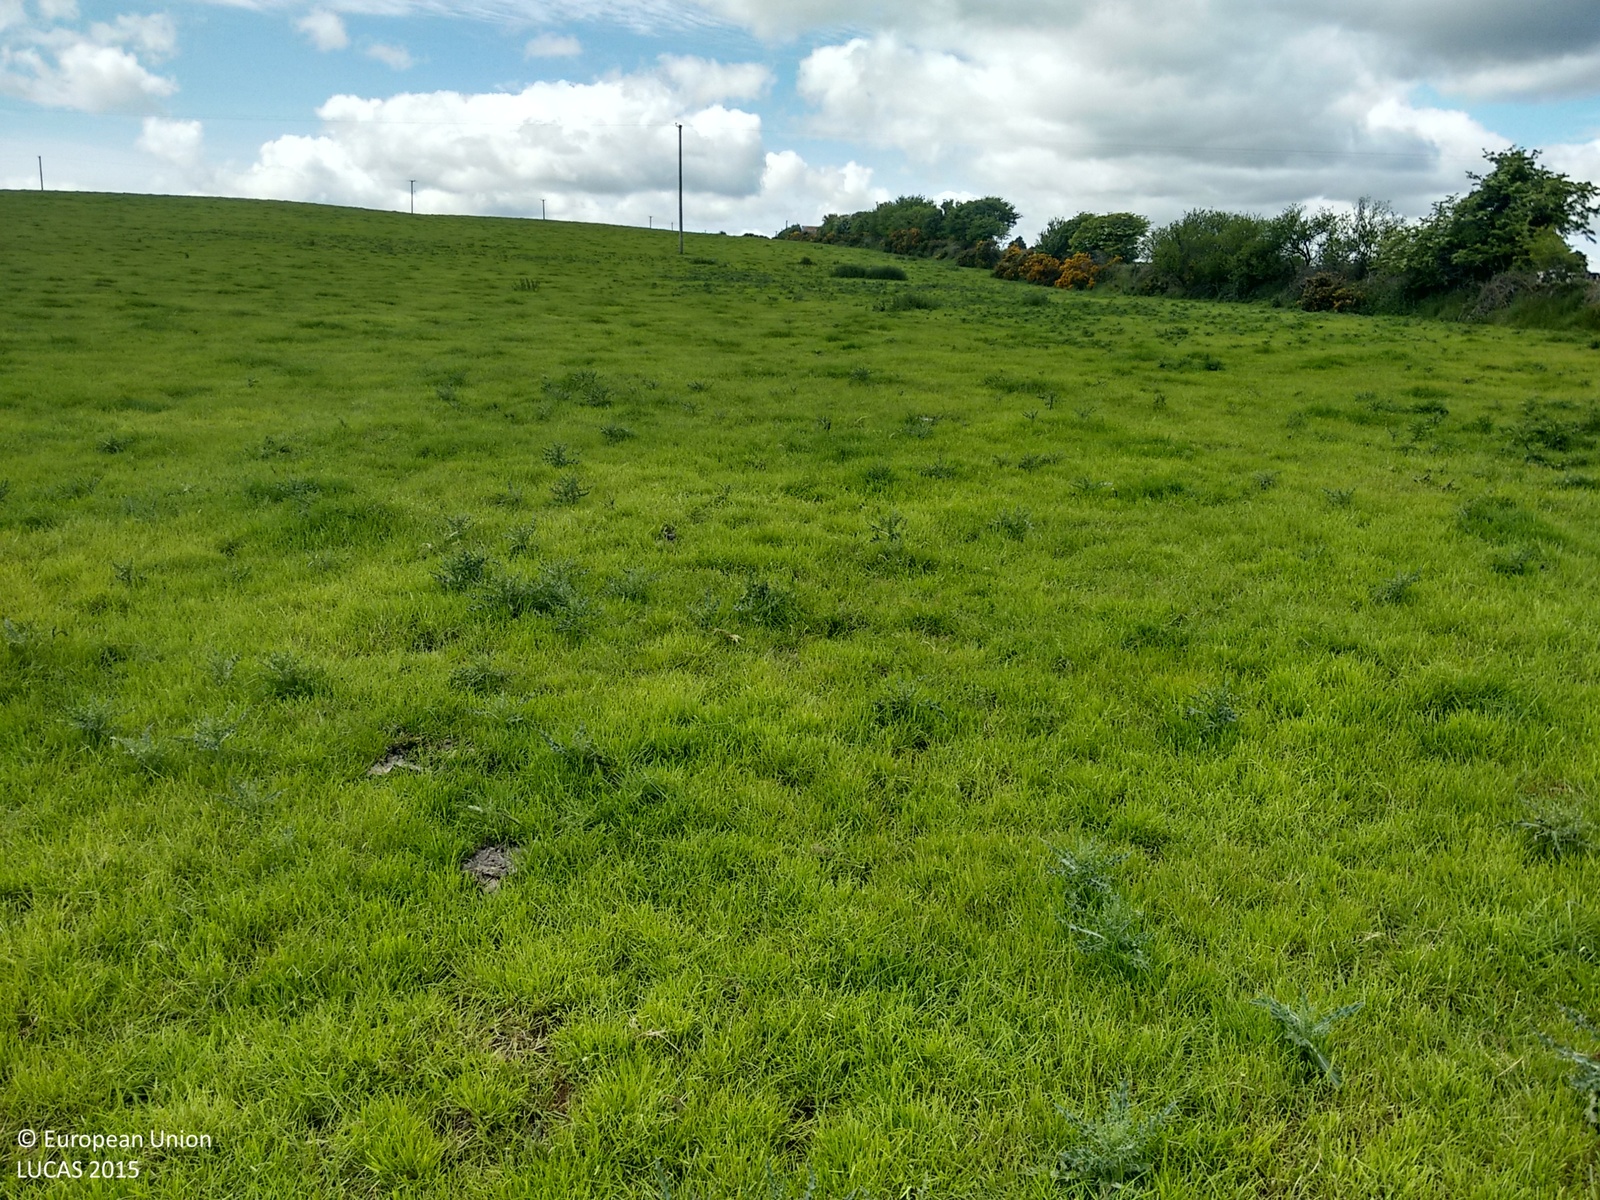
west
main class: Grassland
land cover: Grassland without tree/shrub cover
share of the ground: > 75 %
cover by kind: herbaceous plants 100 %
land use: Agriculture (excluding fallow land and kitchen gardens)
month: May
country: IE
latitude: 51.8229
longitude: -8.7601
